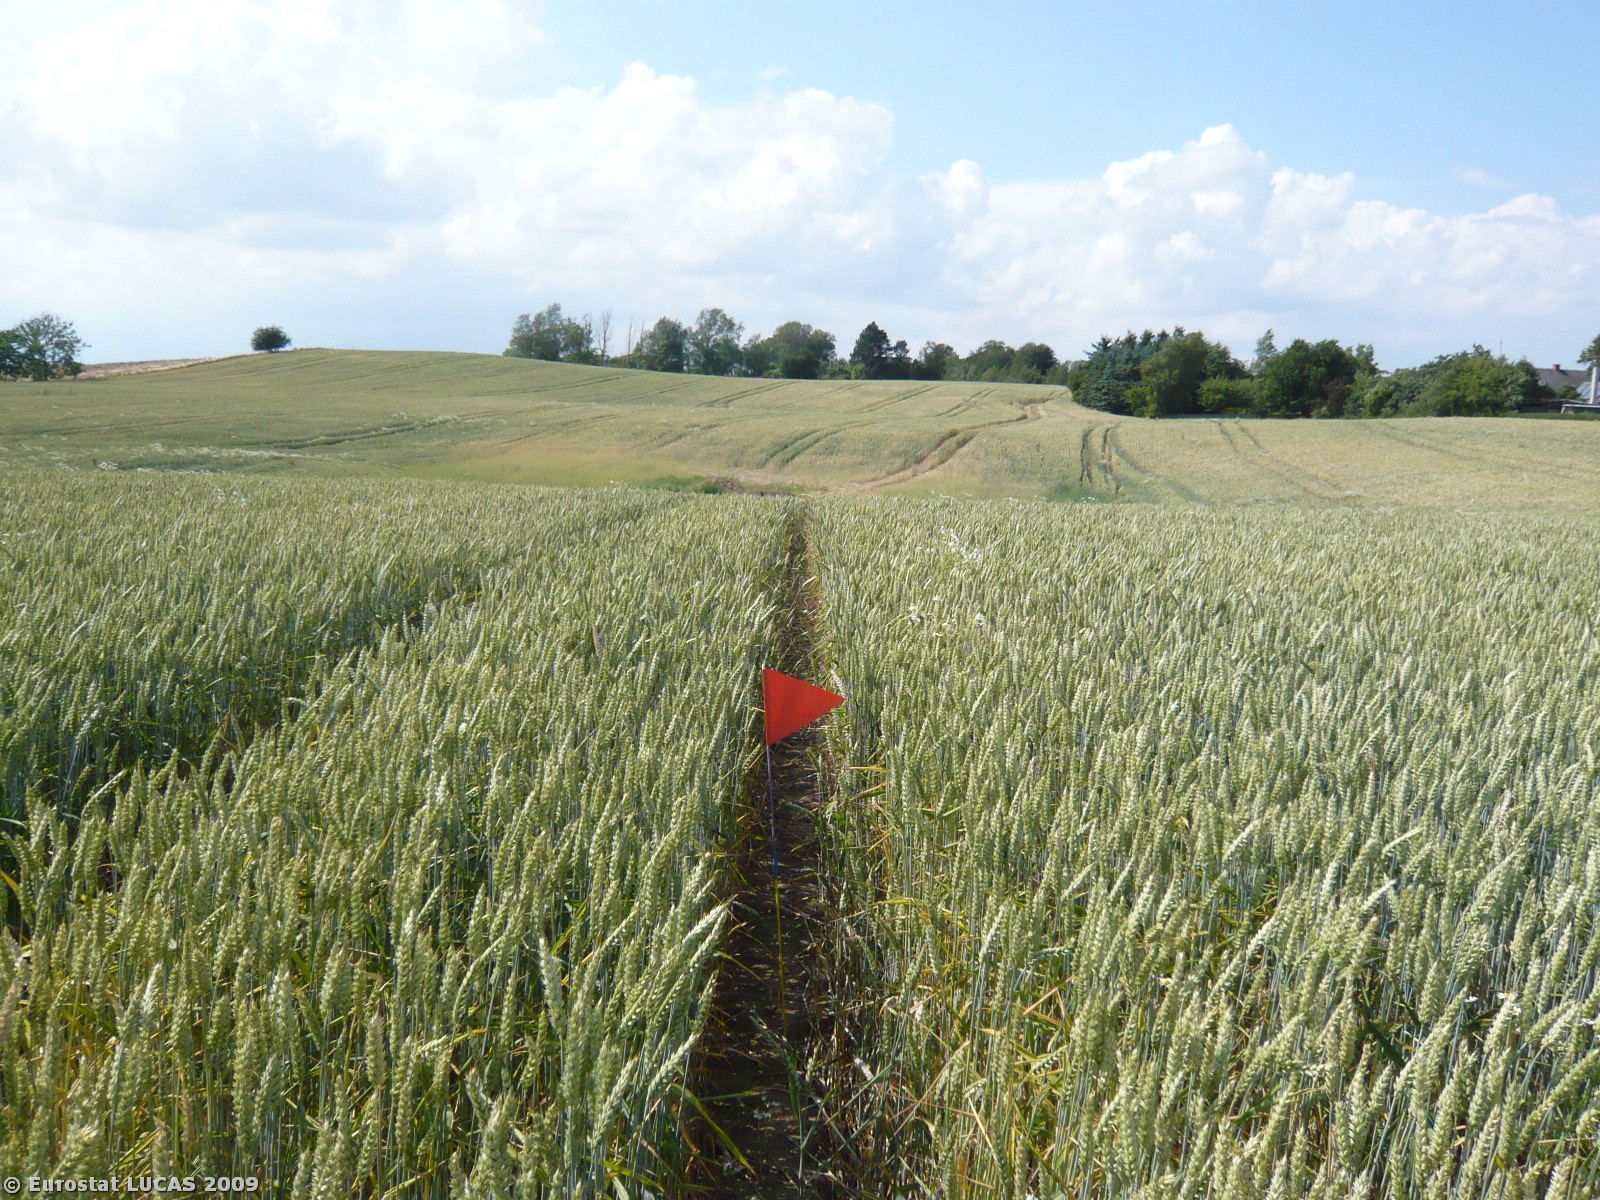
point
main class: Cropland
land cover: Common wheat
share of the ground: > 75 %
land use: Agriculture (excluding fallow land and kitchen gardens)
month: July
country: DK
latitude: 55.5046
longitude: 10.1740
